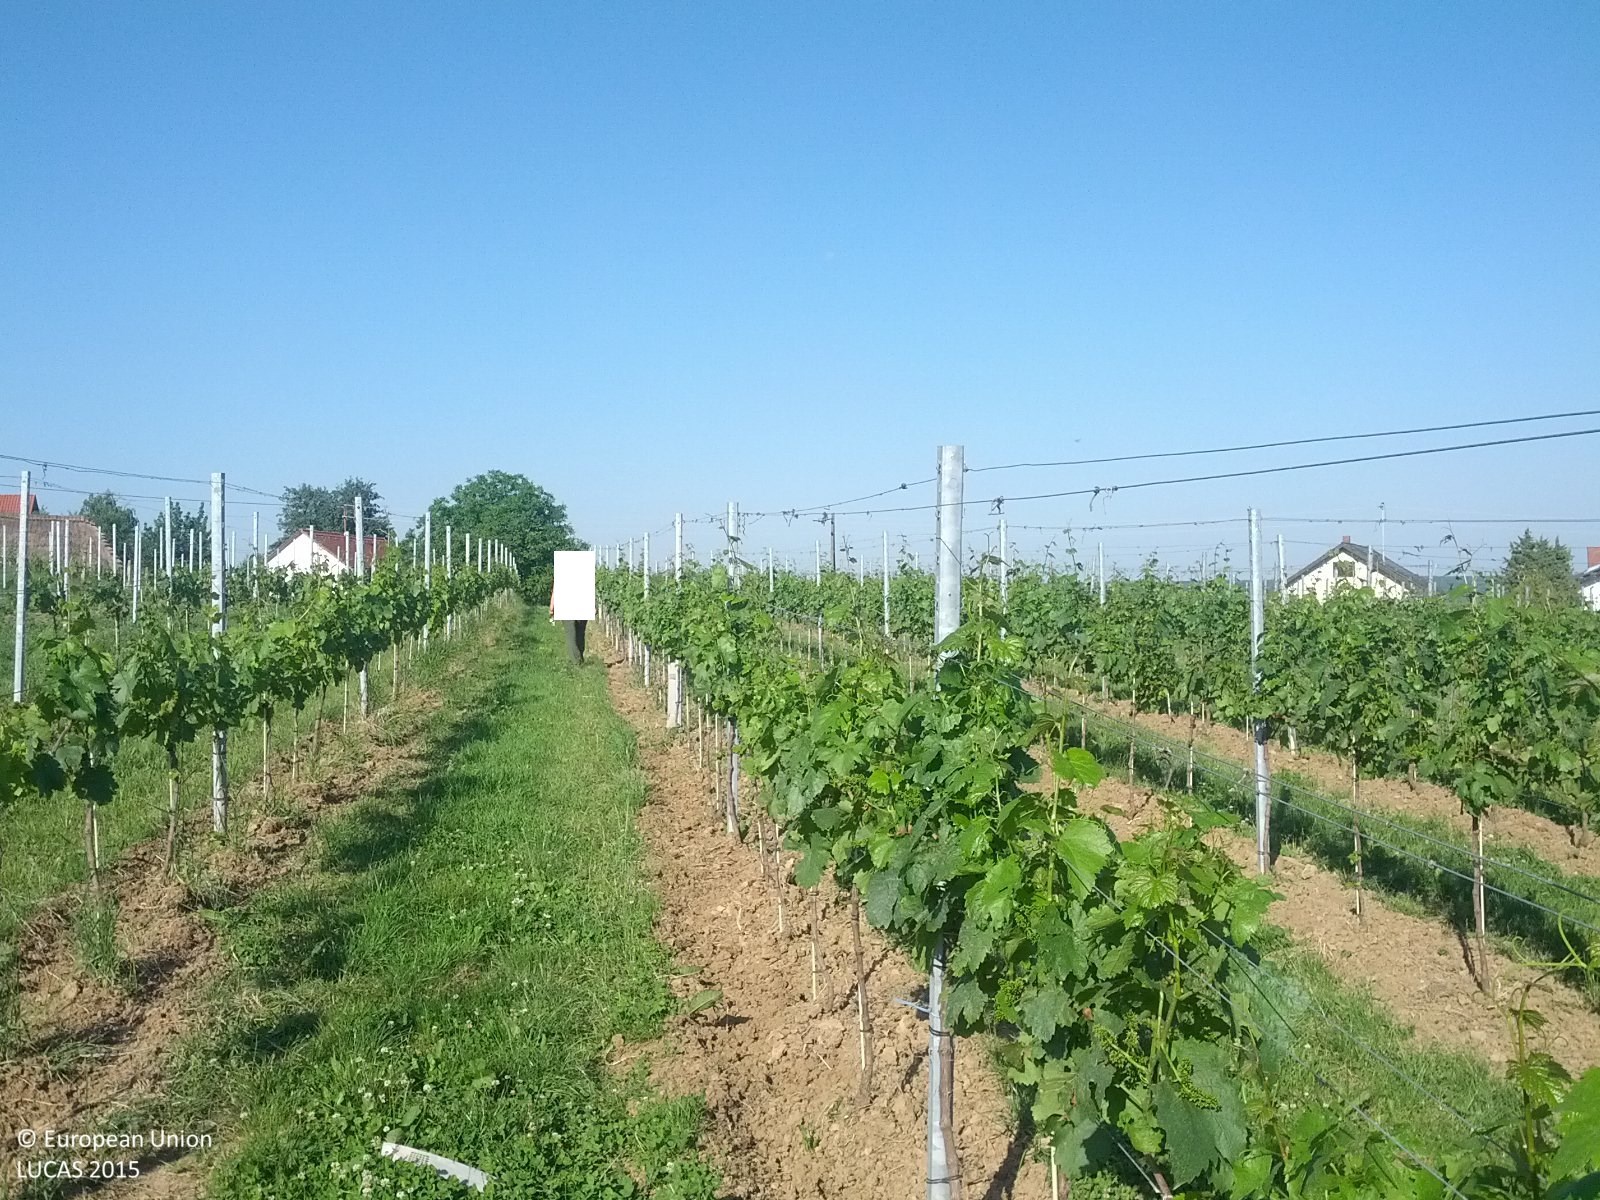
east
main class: Cropland
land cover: Vineyards
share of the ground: 50 - 75 %
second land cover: Grassland without tree/shrub cover
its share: > 75 %
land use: Agriculture (excluding fallow land and kitchen gardens)
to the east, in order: Vineyards; Grassland without tree/shrub cover; Ditches and canals; Grass margins; Artificial constructions in urban areas; Vineyards; Grassland without tree/shrub cover; Temporary grasslands; Vineyards
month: June
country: AT
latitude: 47.1693
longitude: 16.4276
